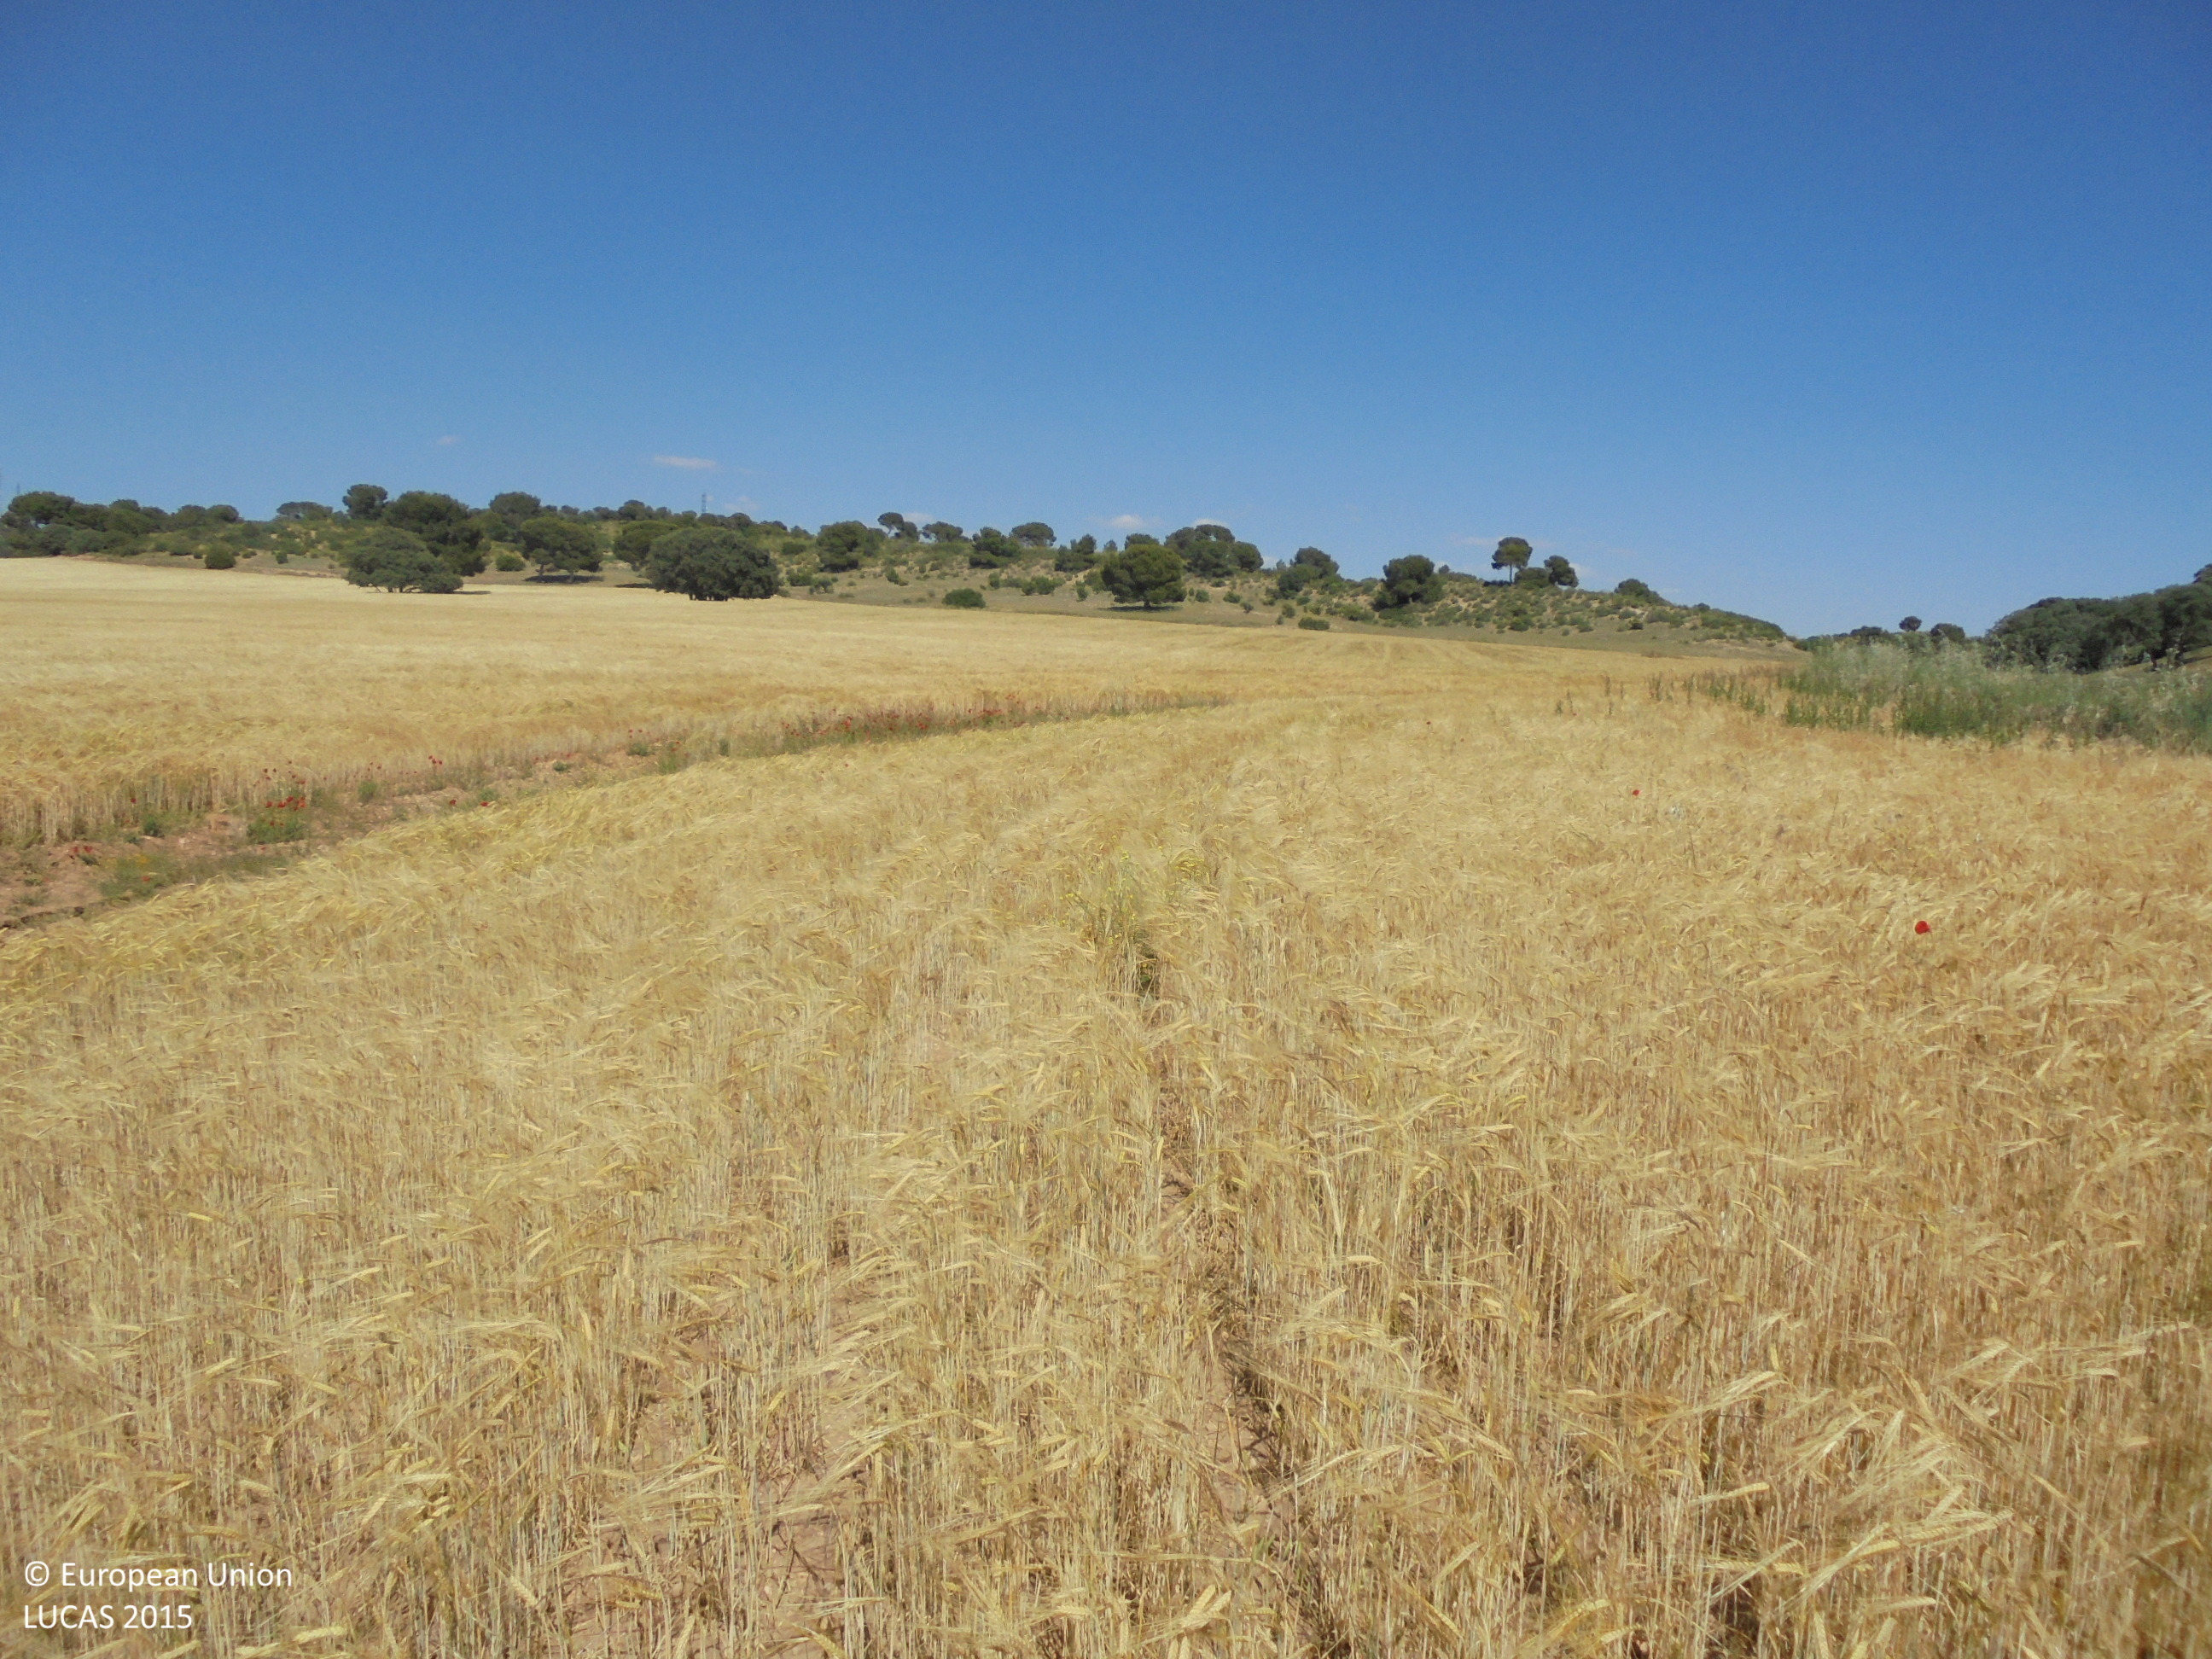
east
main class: Cropland
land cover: Barley
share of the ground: 50 - 75 %
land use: Agriculture (excluding fallow land and kitchen gardens)
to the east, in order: Barley; Grassland without tree/shrub cover; Barley; Grass margins; Tracks; Pine dominated coniferous woodland
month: June
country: ES
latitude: 38.7786
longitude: -1.7033
